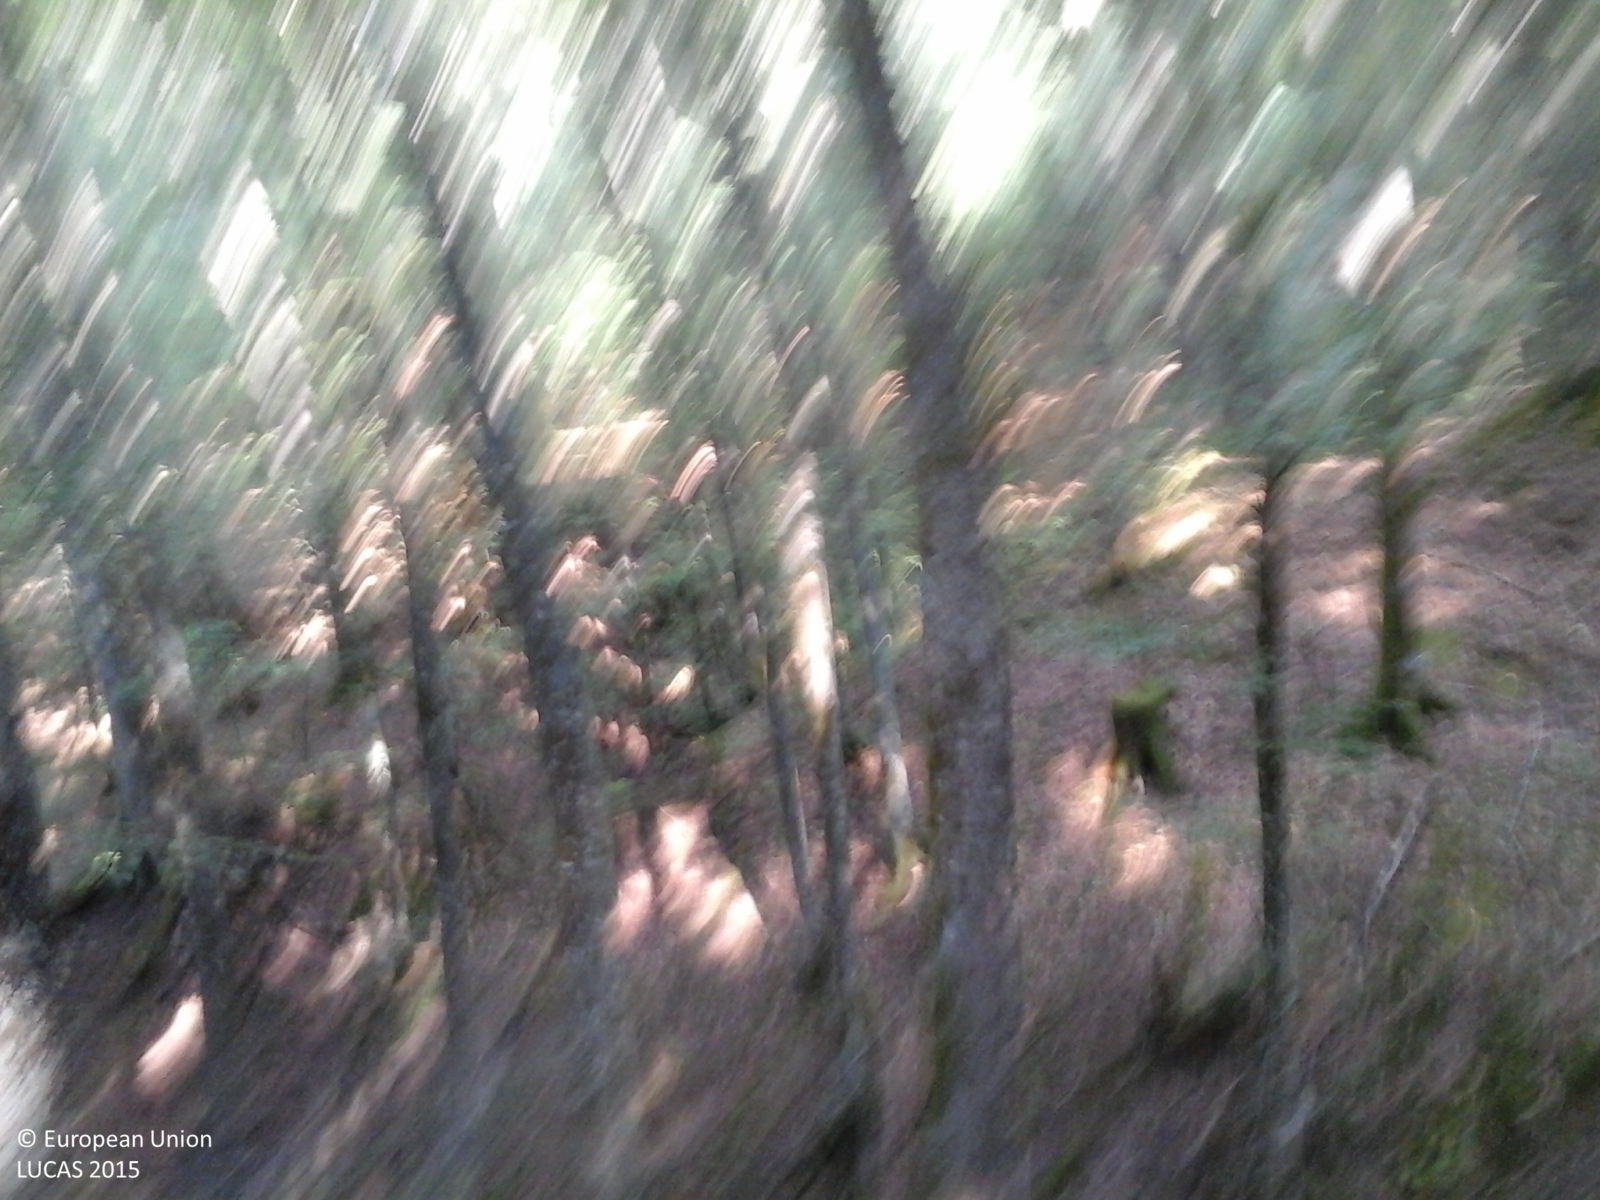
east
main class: Woodland
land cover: Broadleaved woodland
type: mountainous beech forest
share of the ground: > 75 %
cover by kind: broadleaved forest trees 90 %, lichens and mosses 10 %
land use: Semi-natural and natural areas not in use
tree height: > 5 m
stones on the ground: < 10 %
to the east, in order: Broadleaved woodland
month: August
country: IT
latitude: 43.8108
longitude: 11.8476
